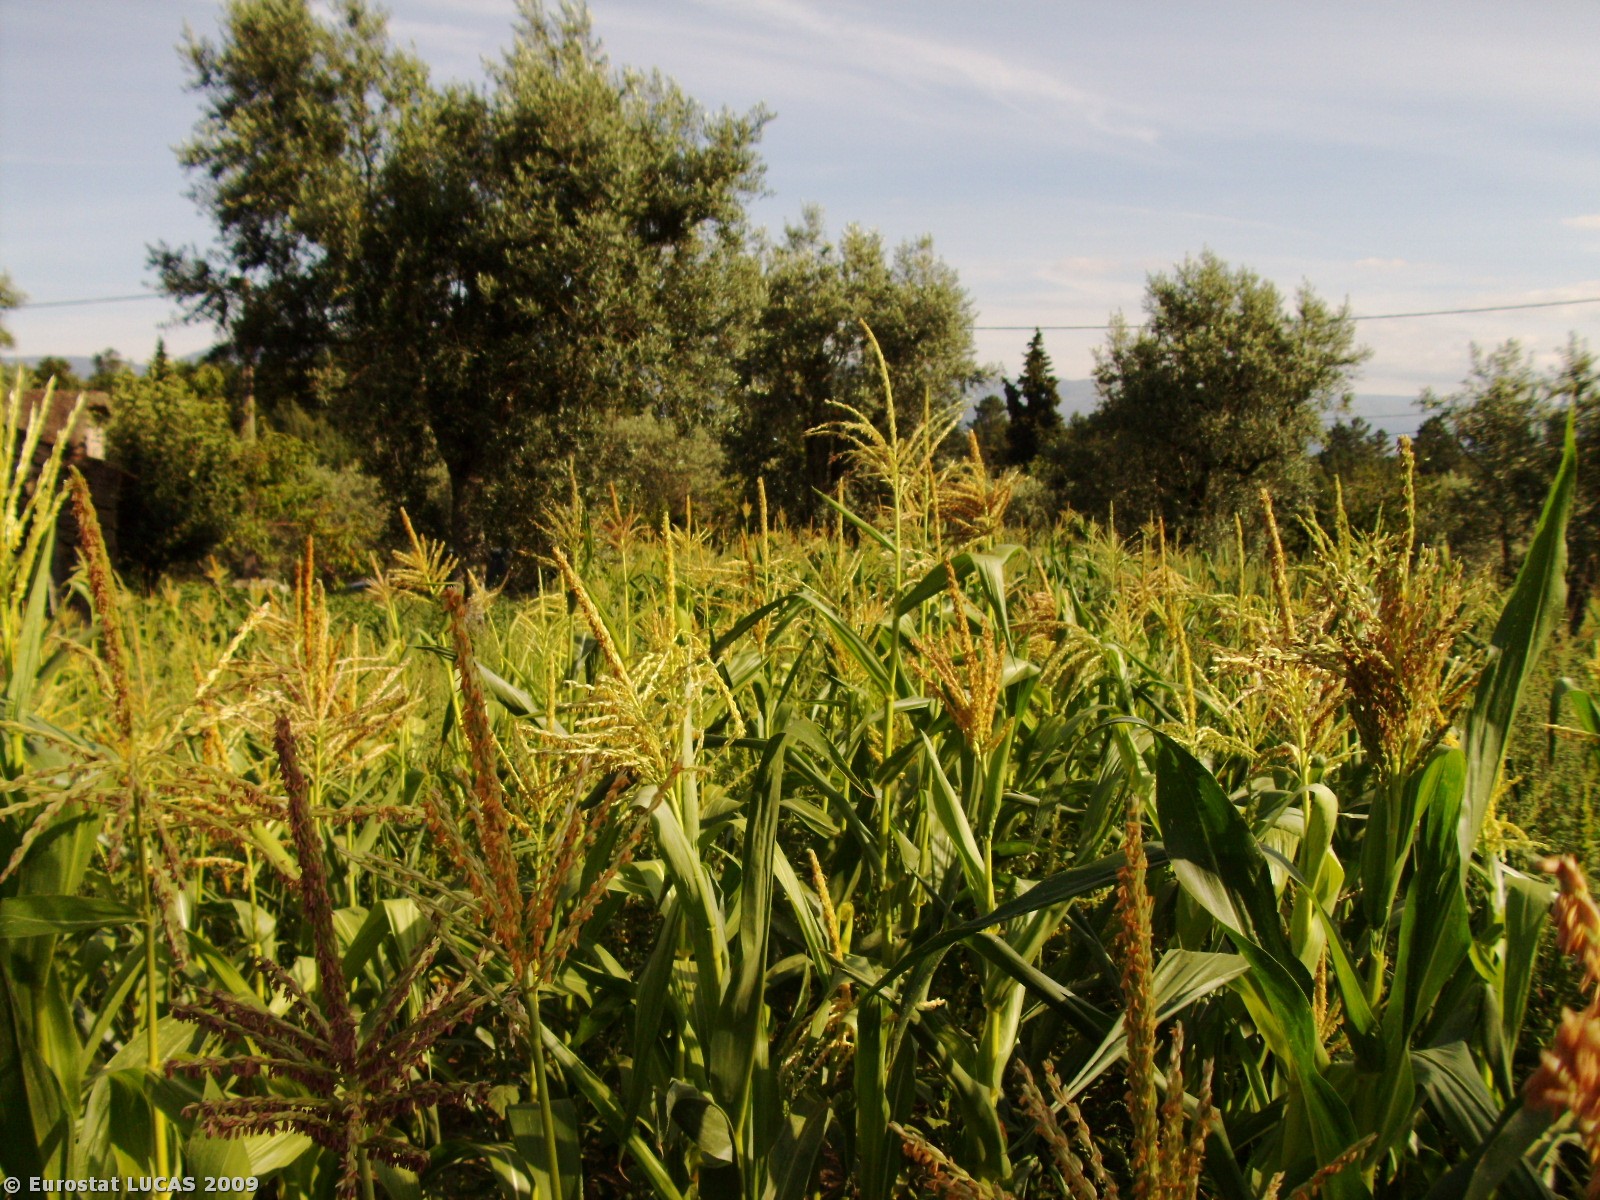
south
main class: Cropland
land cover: Olive groves
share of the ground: 10 - 25 %
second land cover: Maize
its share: > 75 %
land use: Agriculture (excluding fallow land and kitchen gardens)
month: July
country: PT
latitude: 40.5799
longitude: -7.6114
